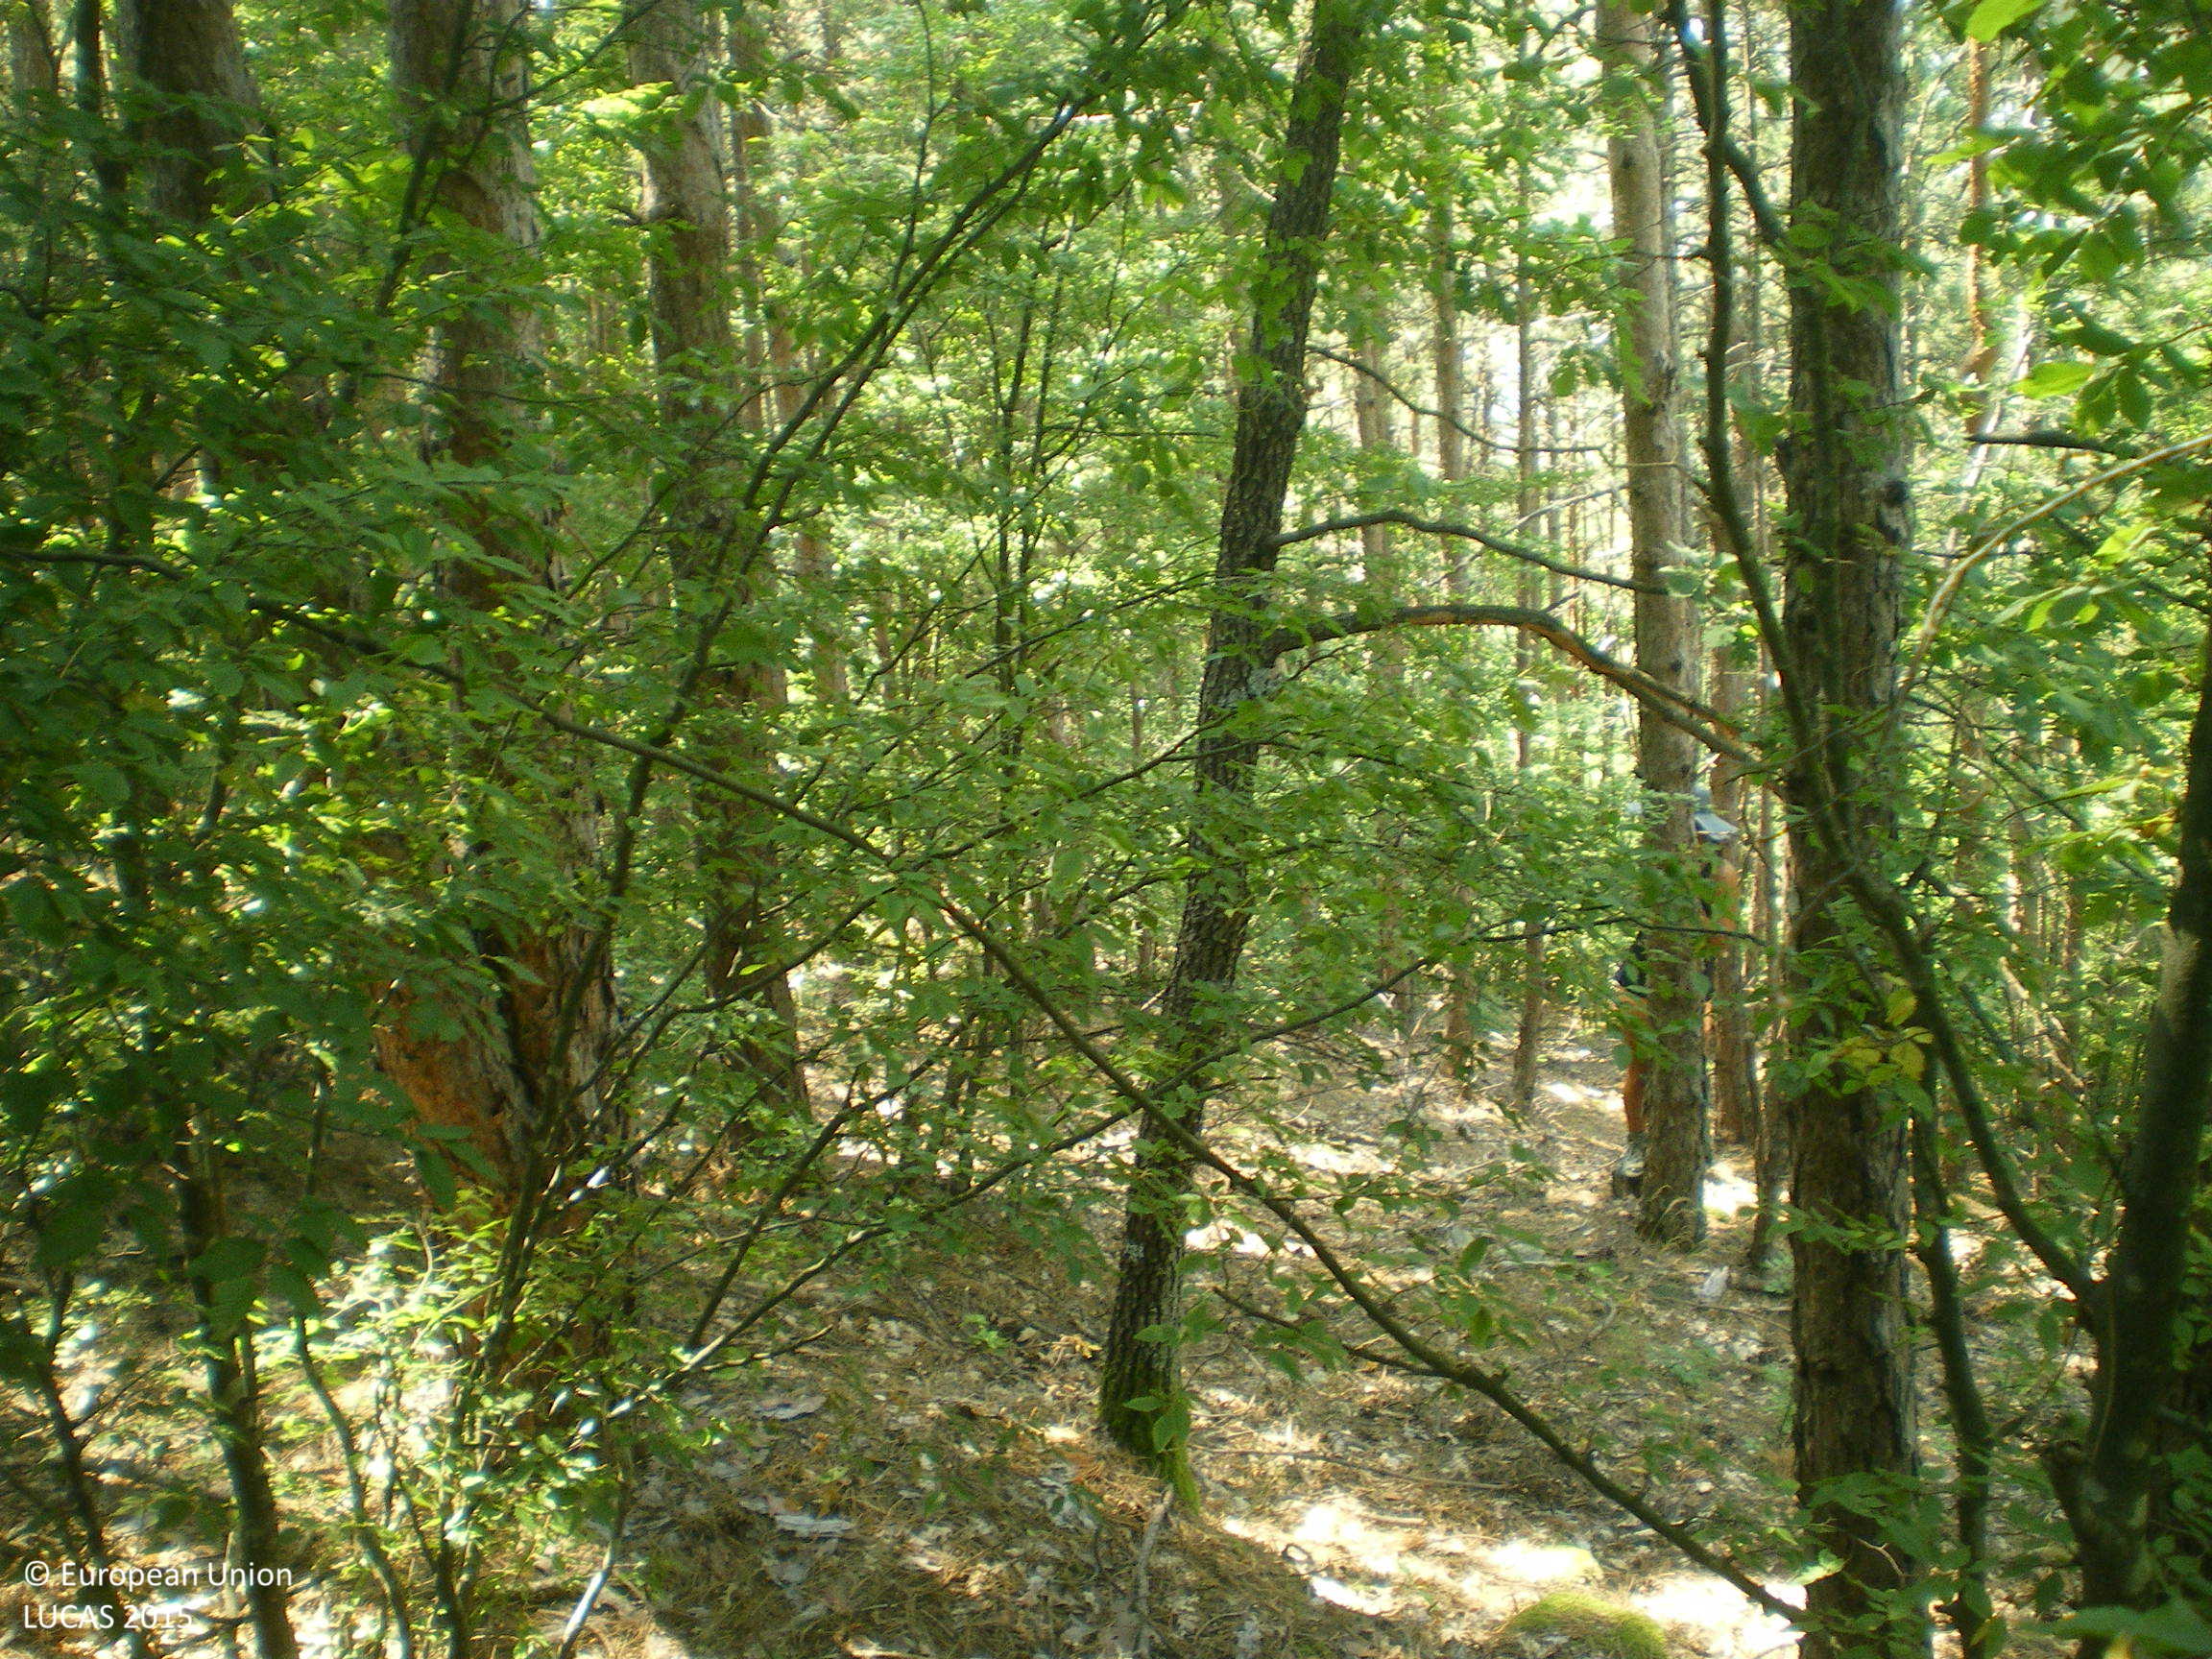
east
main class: Woodland
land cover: Pine dominated coniferous woodland
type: coniferous forest of the mediterranean region
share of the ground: > 75 %
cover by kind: coniferous forest trees 75 %, broadleaved forest trees 25 %
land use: Forestry
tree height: > 5 m
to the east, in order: Pine dominated coniferous woodland; Tracks; Pine dominated coniferous woodland; Tracks; Pine dominated mixed woodland; Tracks; Pine dominated mixed woodland; Broadleaved woodland
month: July
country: BG
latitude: 42.6757
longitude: 25.0606
